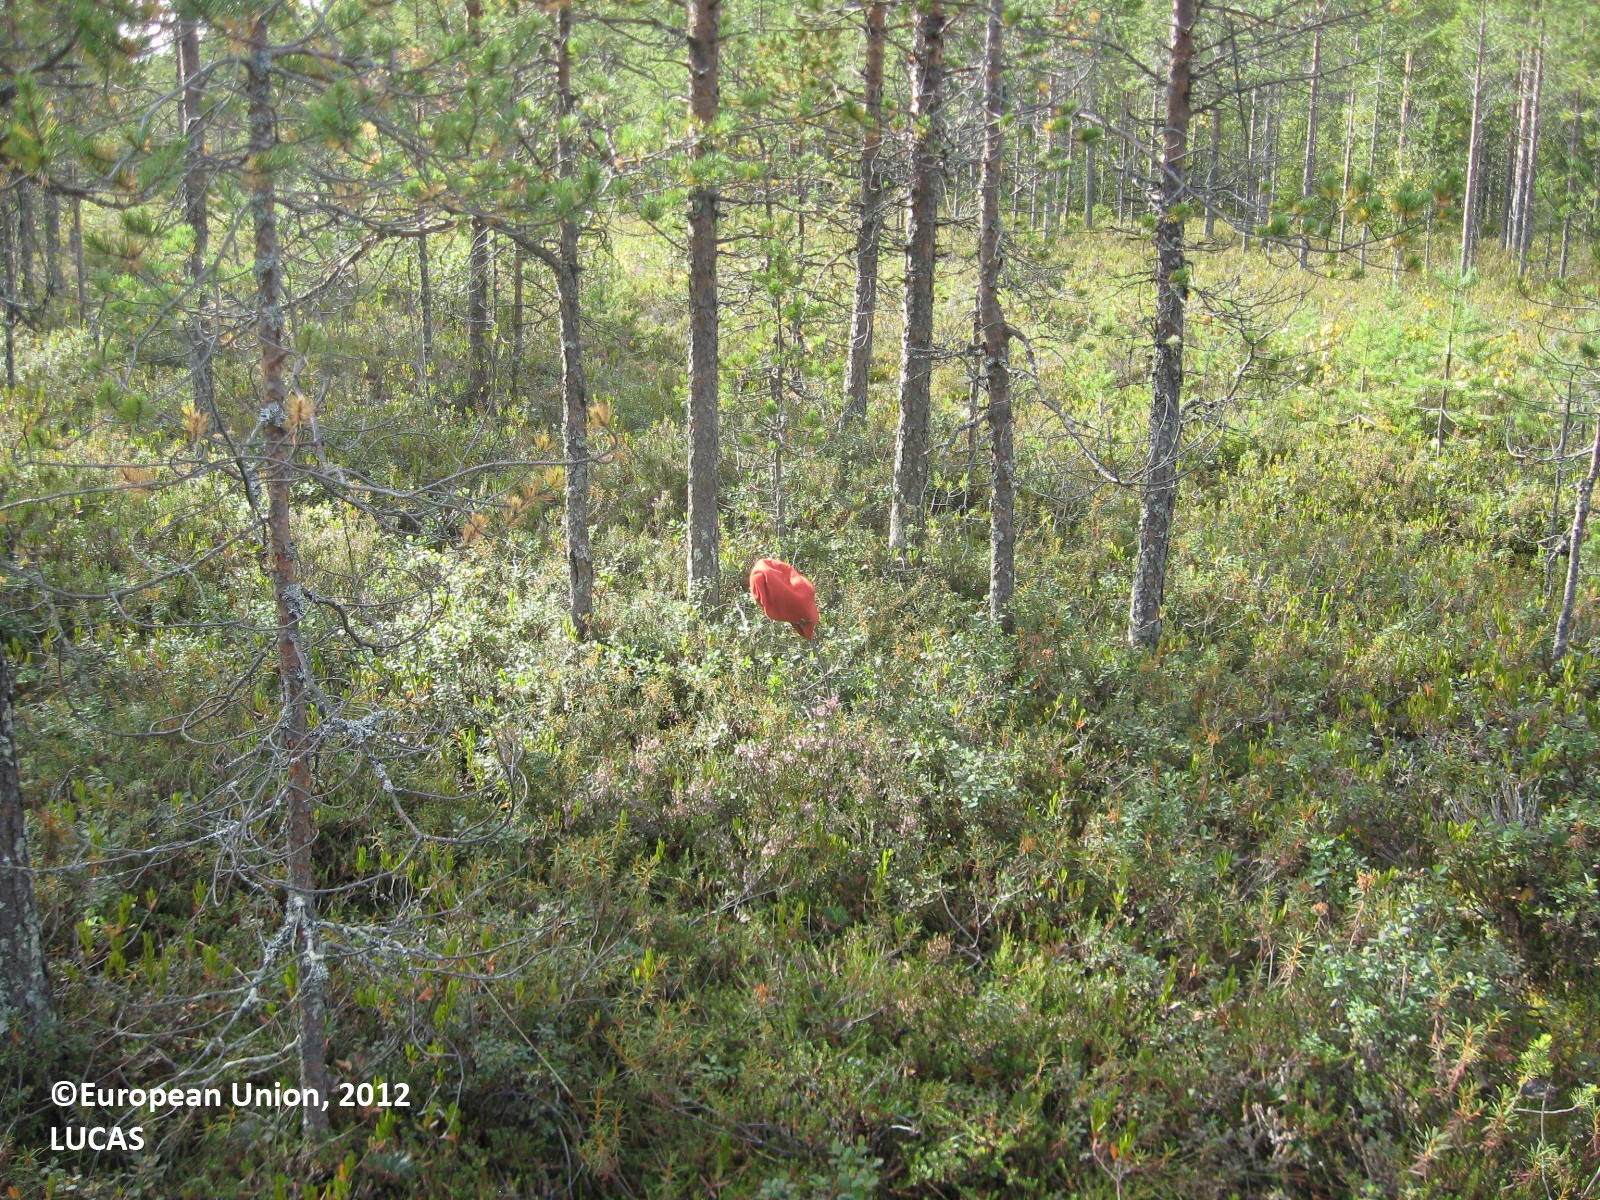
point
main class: Woodland
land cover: Pine dominated coniferous woodland
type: boreal forest
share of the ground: 25 - 50 %
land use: Forestry
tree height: > 5 m
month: August
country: FI
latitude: 63.5965
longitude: 29.5157
